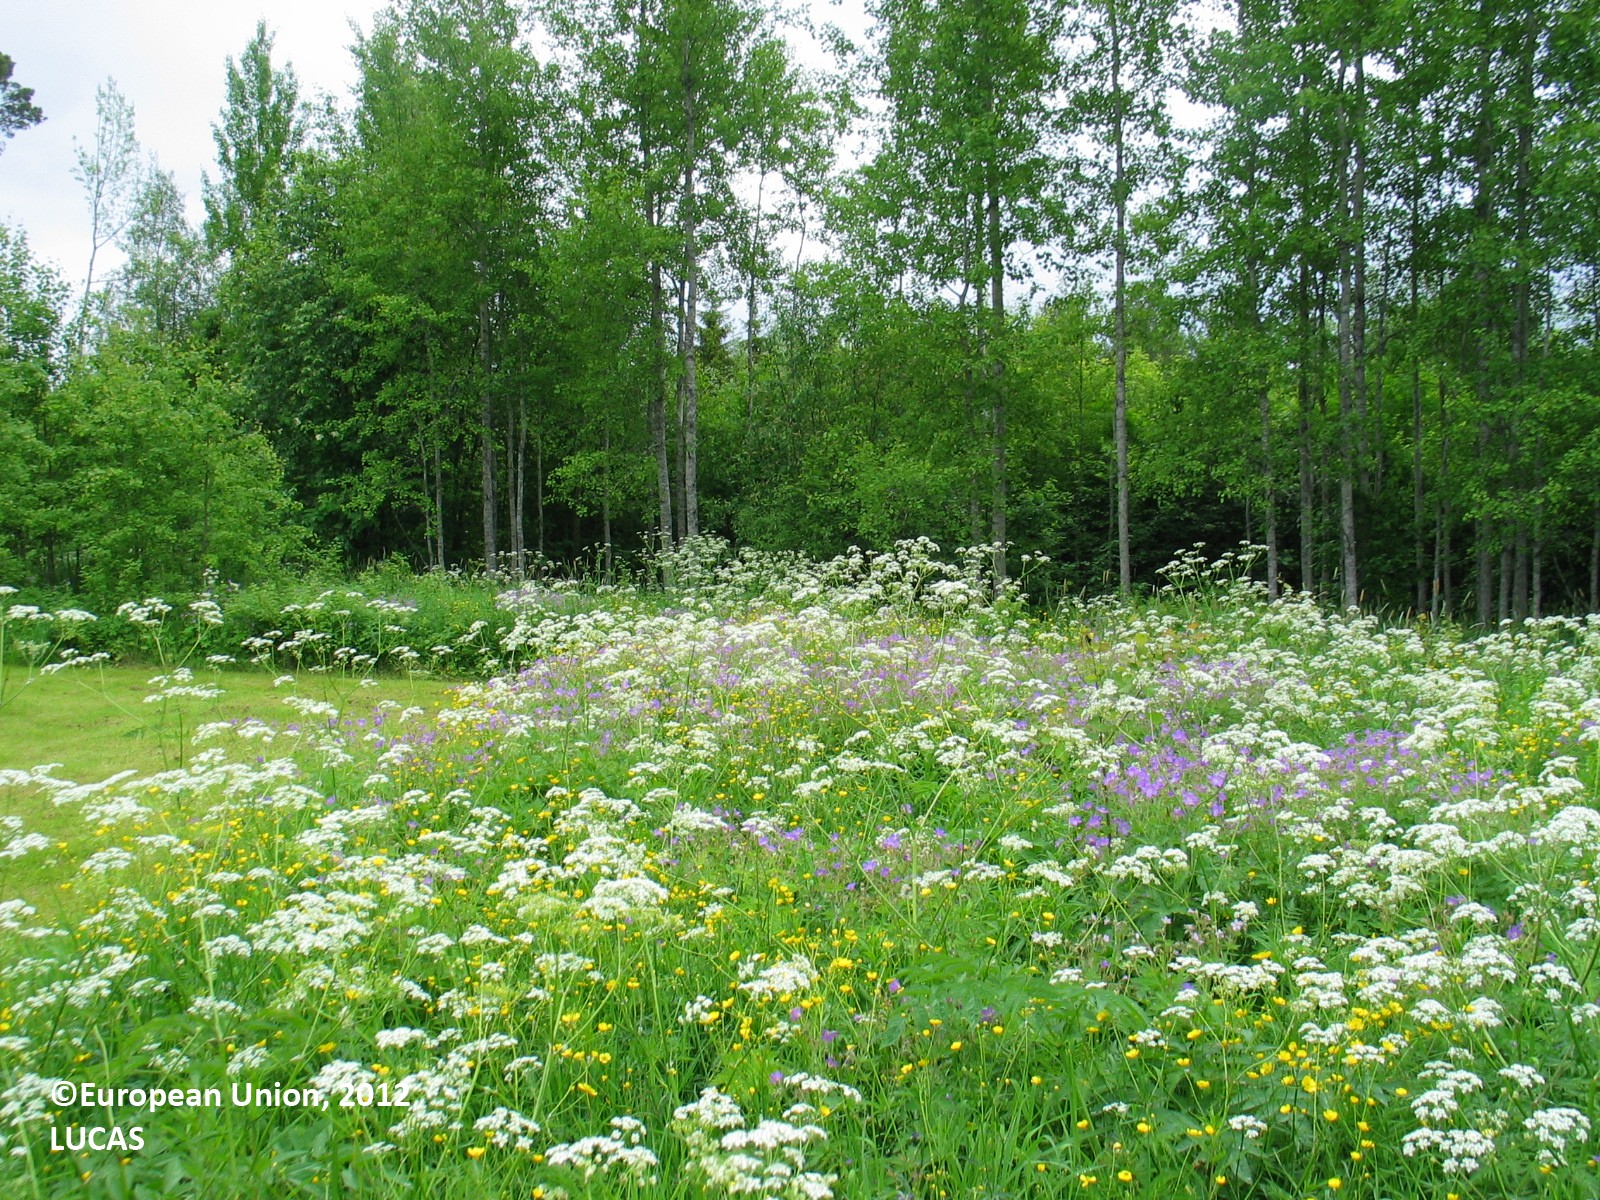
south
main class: Grassland
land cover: Grassland without tree/shrub cover
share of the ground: > 75 %
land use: Residential
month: June
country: FI
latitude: 65.1935
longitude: 25.3951
